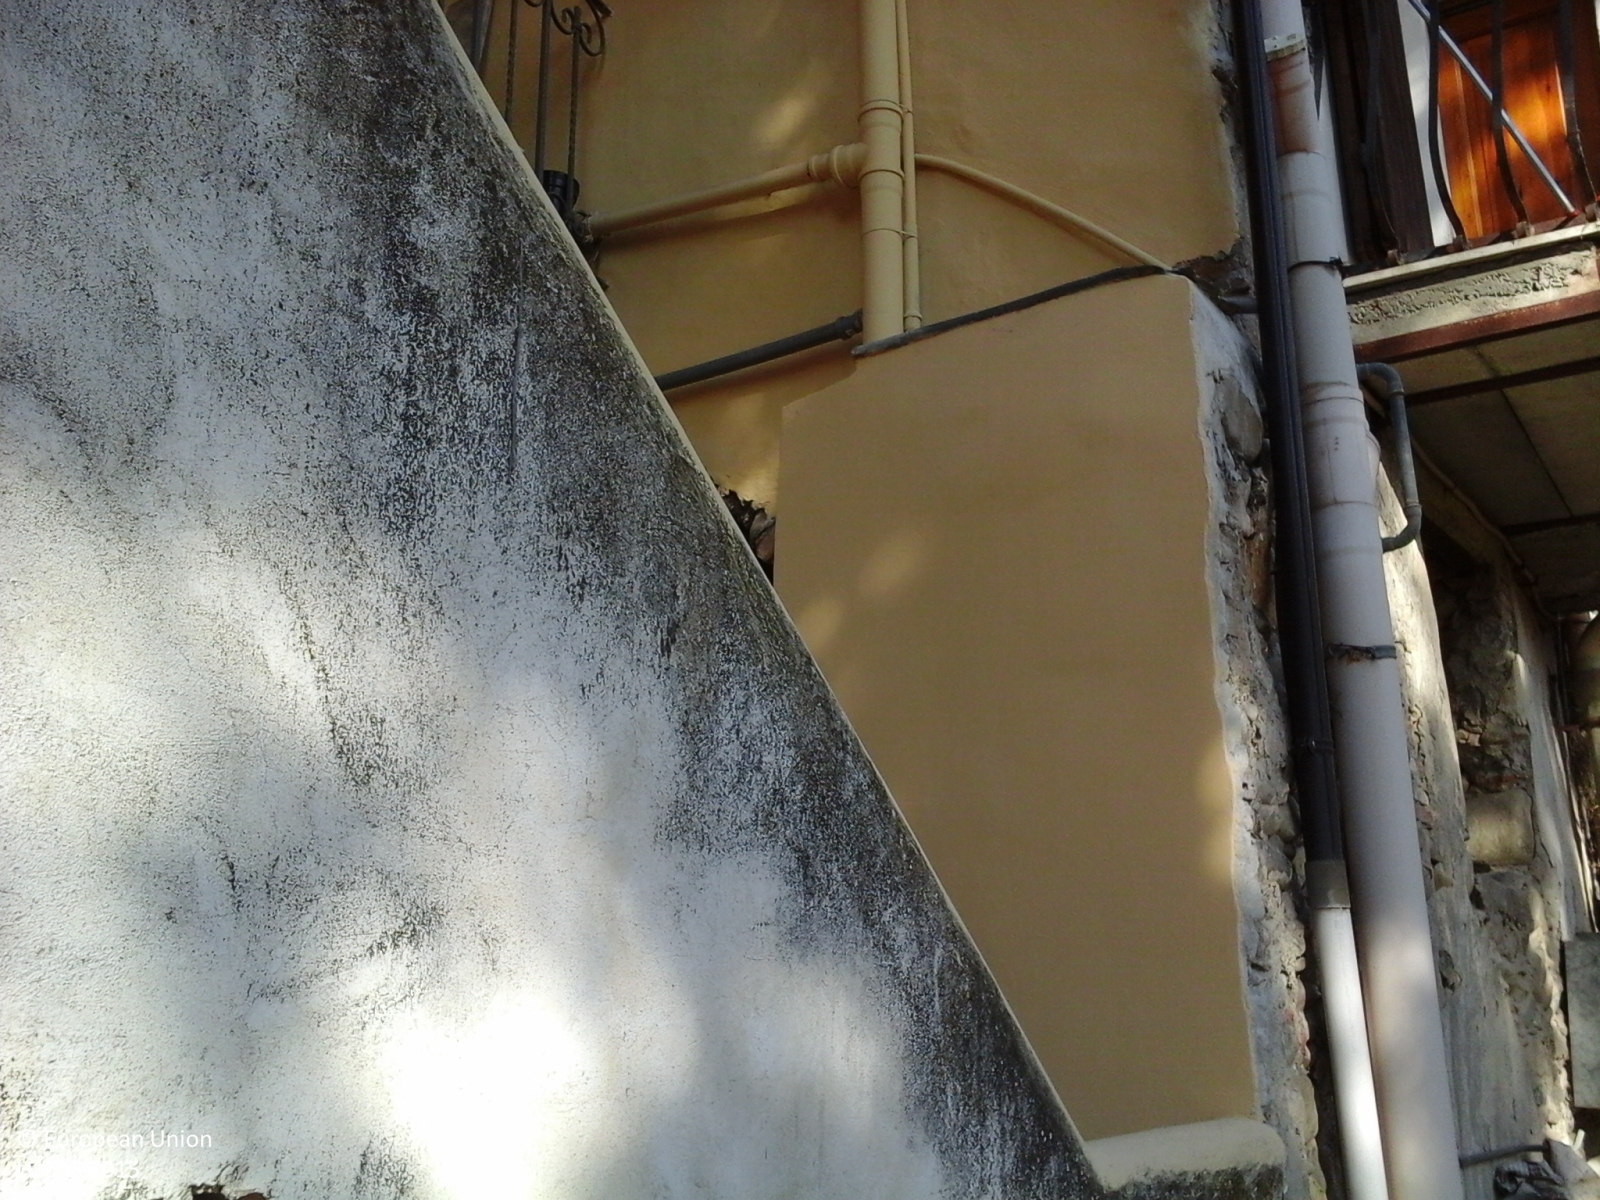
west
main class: Cropland
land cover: Other citrus fruit
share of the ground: 50 - 75 %
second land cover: Grassland without tree/shrub cover
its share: 50 - 75 %
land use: Kitchen garden
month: October
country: IT
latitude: 43.8592
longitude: 7.8529
